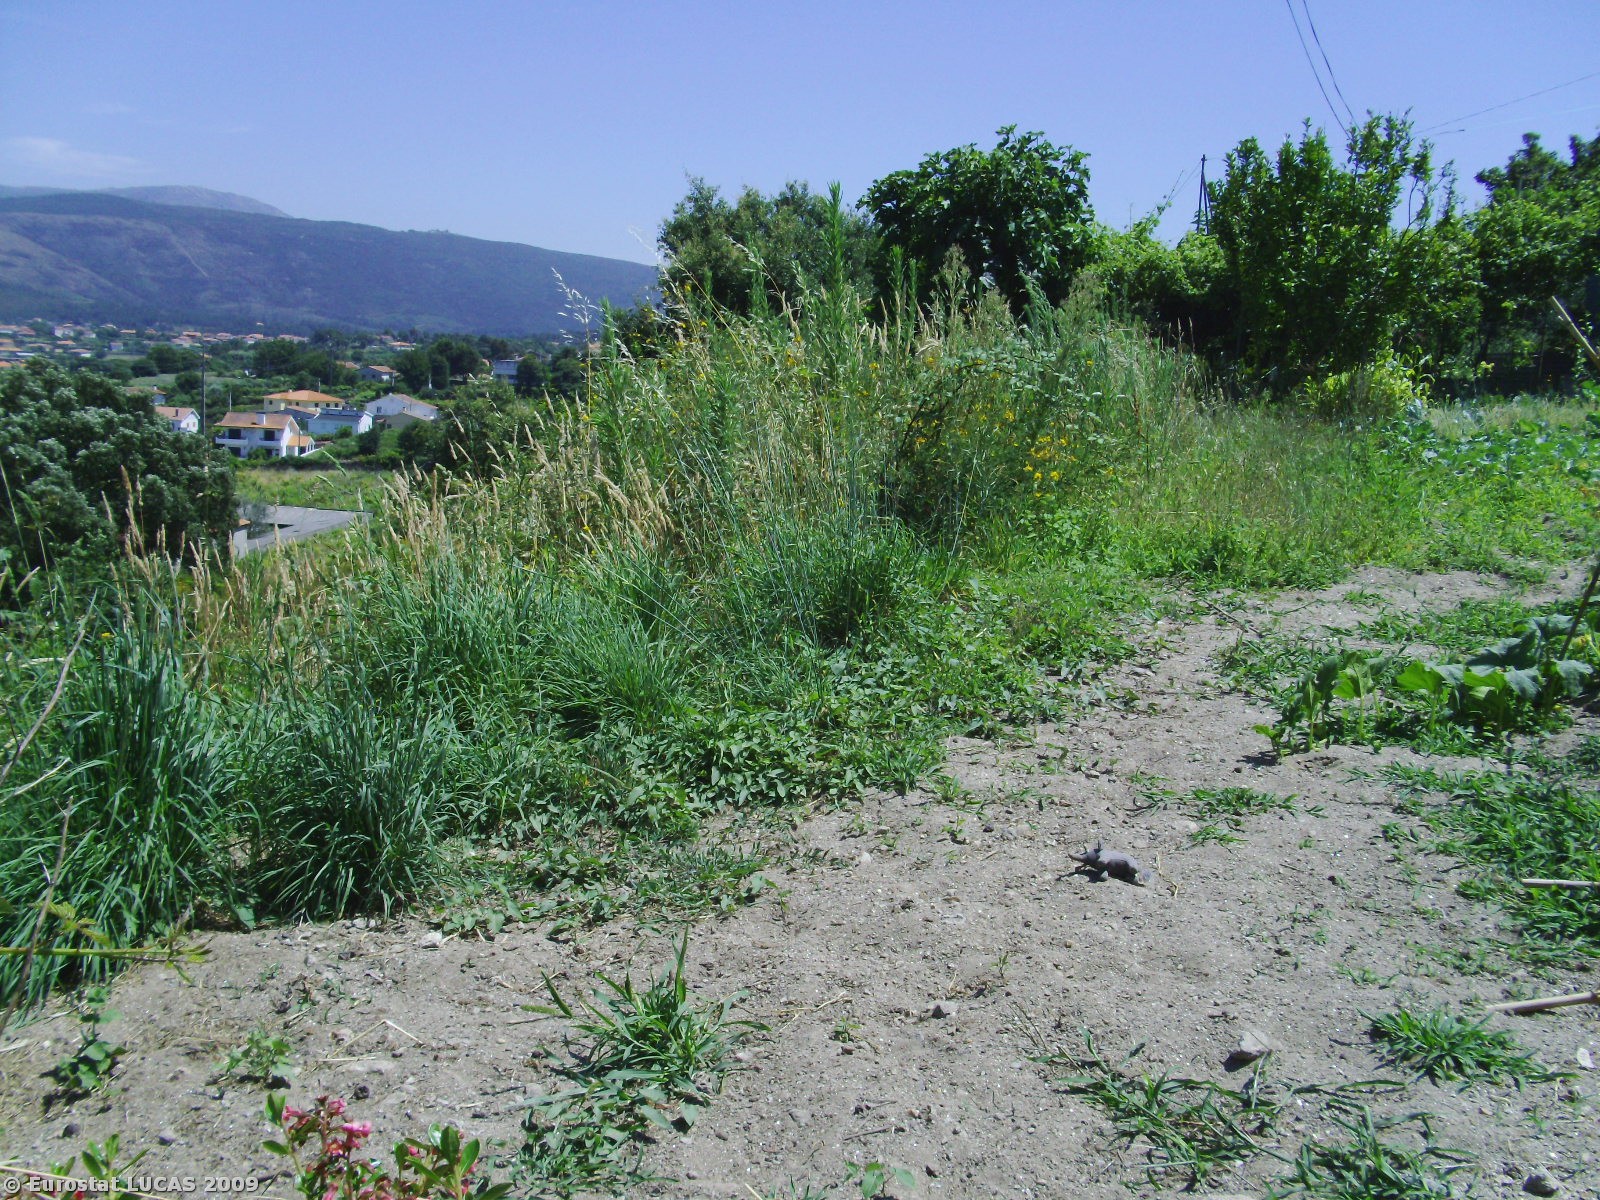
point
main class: Grassland
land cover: Spontaneously vegetated surfaces
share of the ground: > 75 %
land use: Fallow land
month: July
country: PT
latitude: 41.8670
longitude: -8.8335
